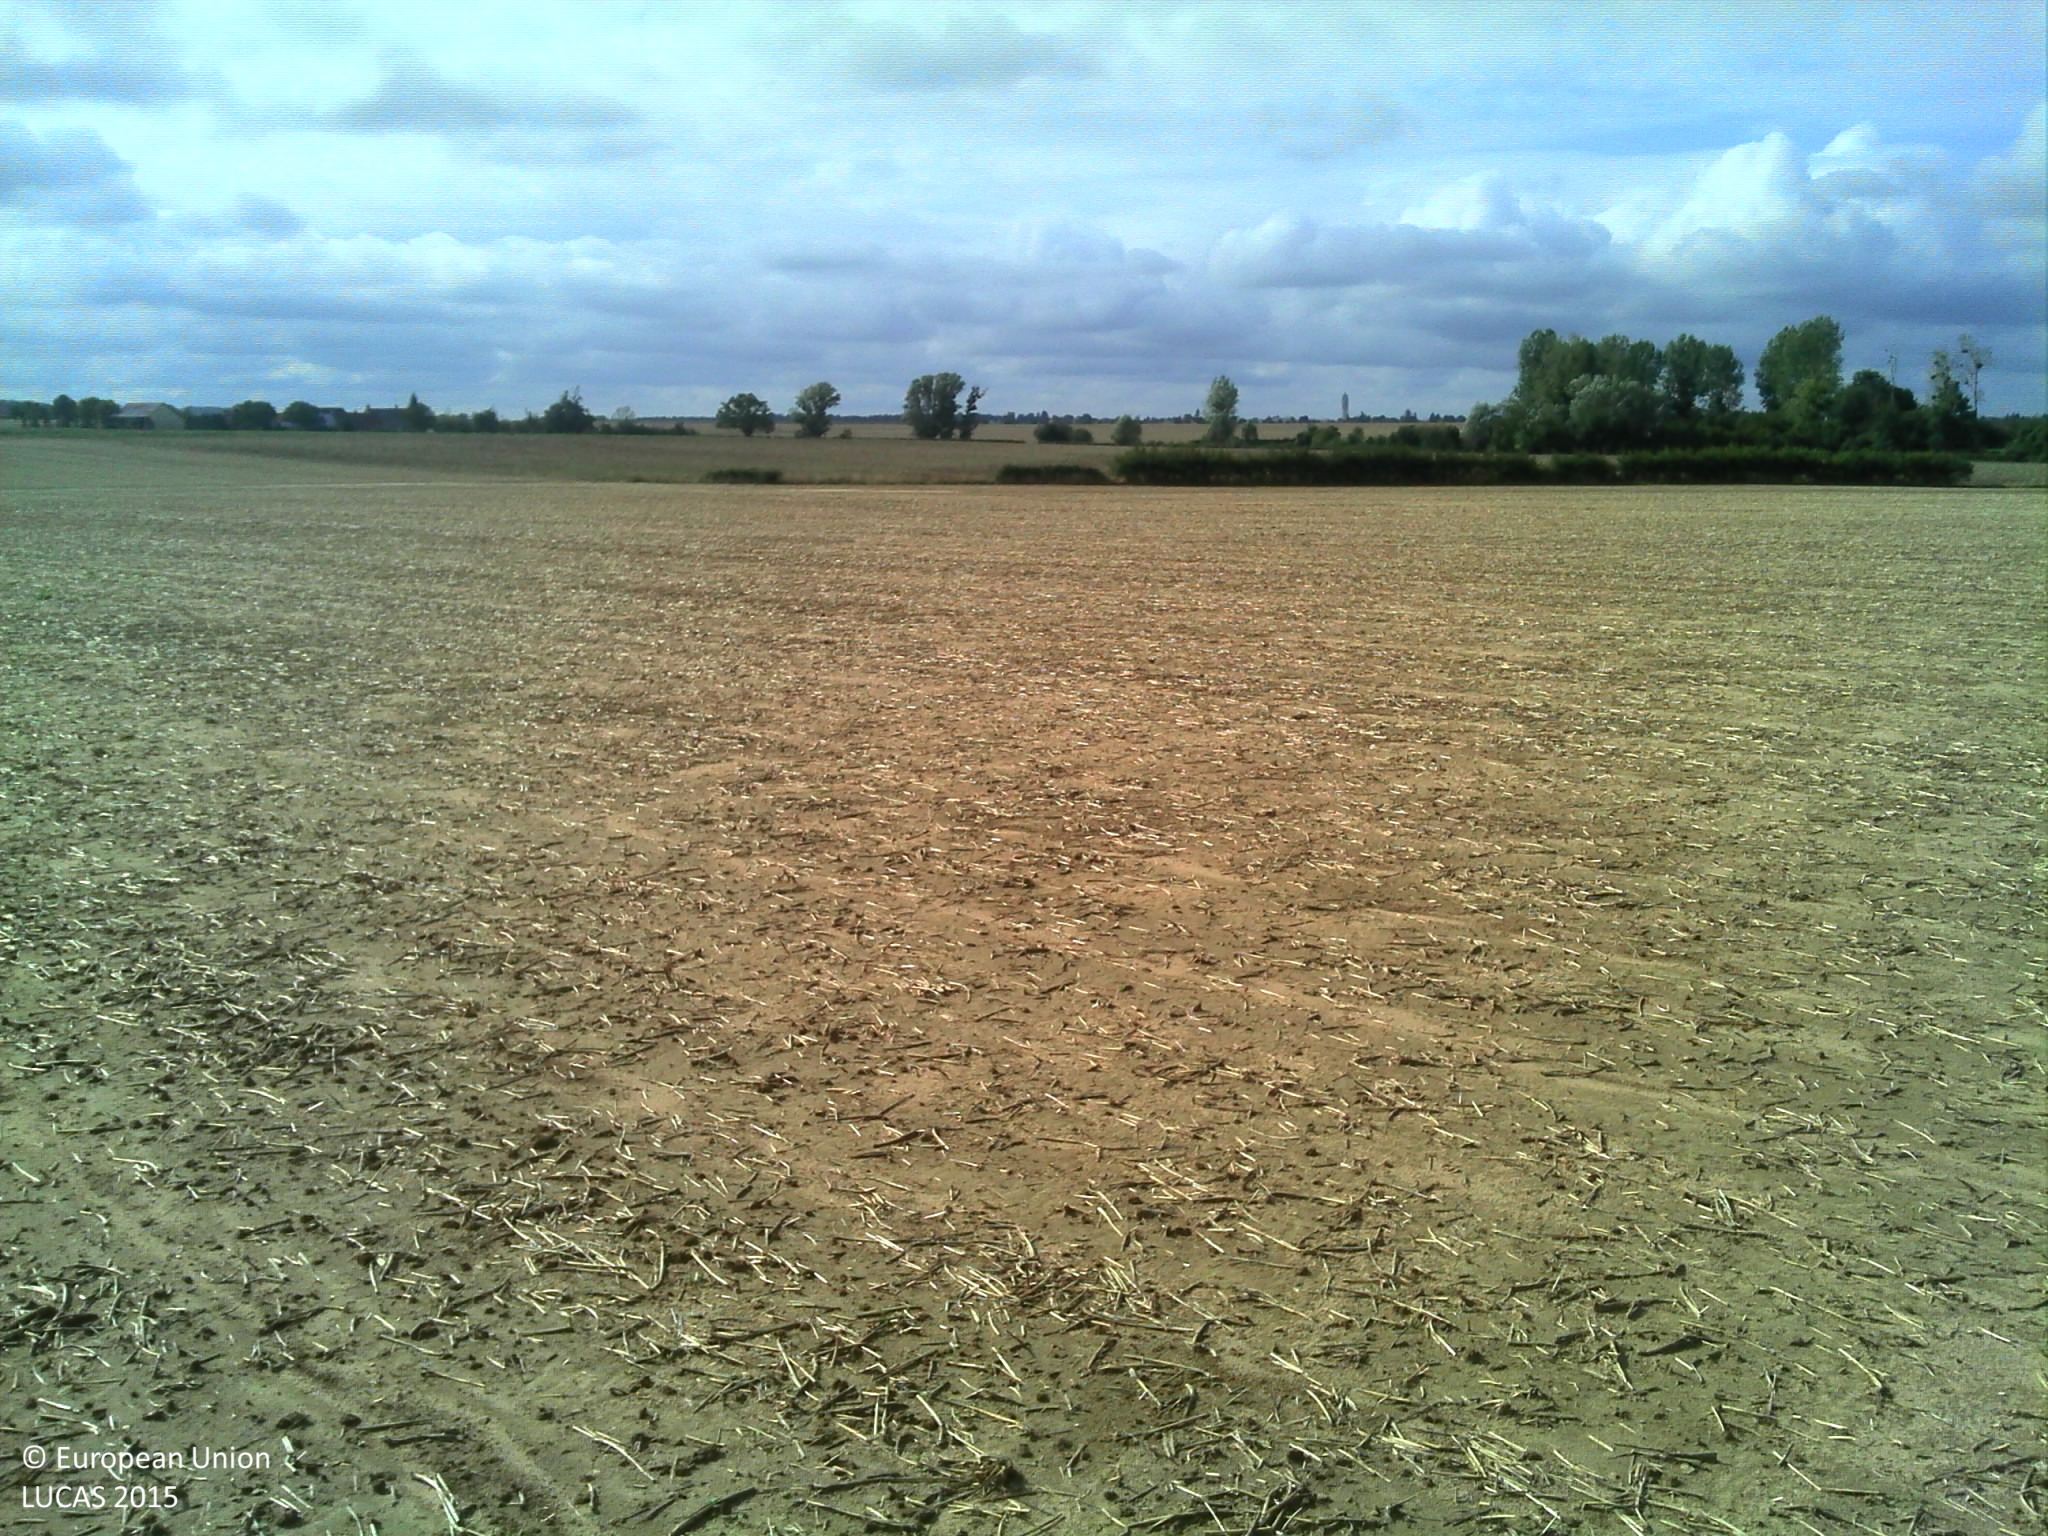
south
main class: Cropland
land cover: Other fibre and oleaginous crops
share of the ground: < 10 %
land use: Agriculture (excluding fallow land and kitchen gardens)
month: September
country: FR
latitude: 46.9129
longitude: 1.4403
